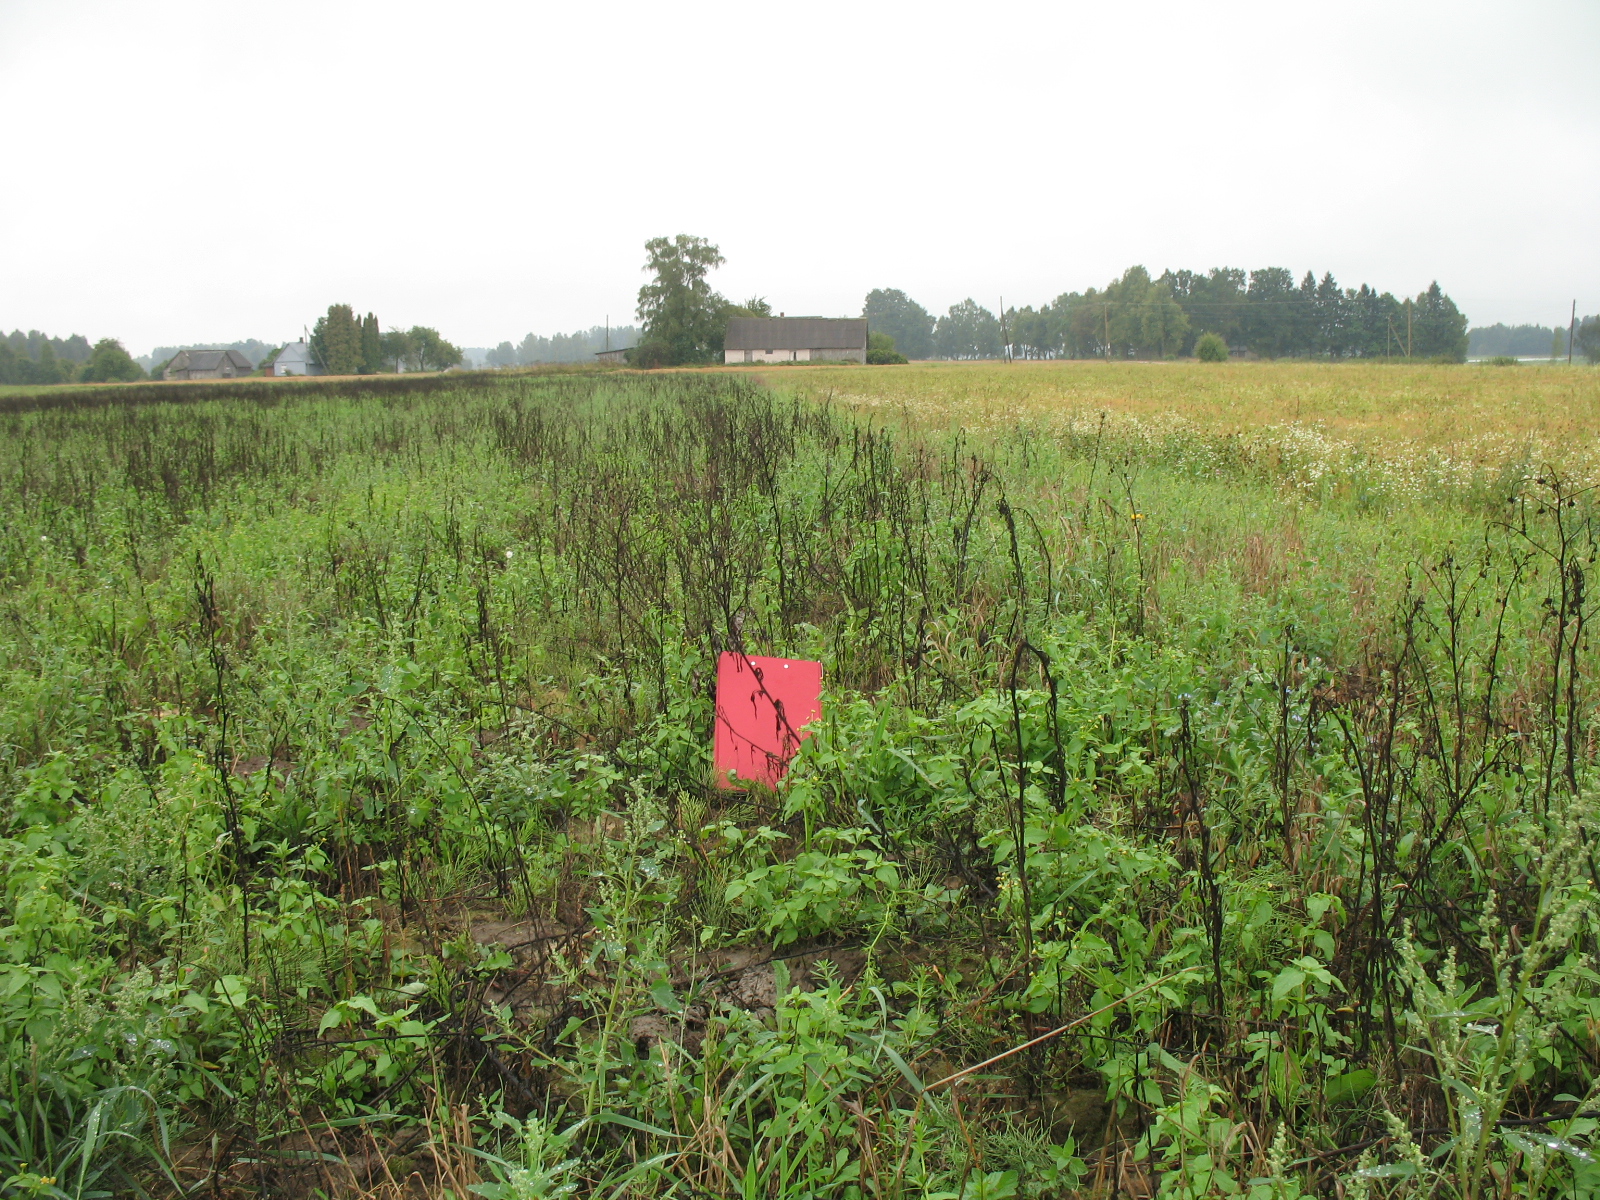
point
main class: Grassland
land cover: Spontaneously vegetated surfaces
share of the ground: > 75 %
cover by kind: herbaceous plants 80 %, unconsolidated bare surface 20 %
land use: Fallow land
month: September
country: LV
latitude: 56.0822
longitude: 26.2268
